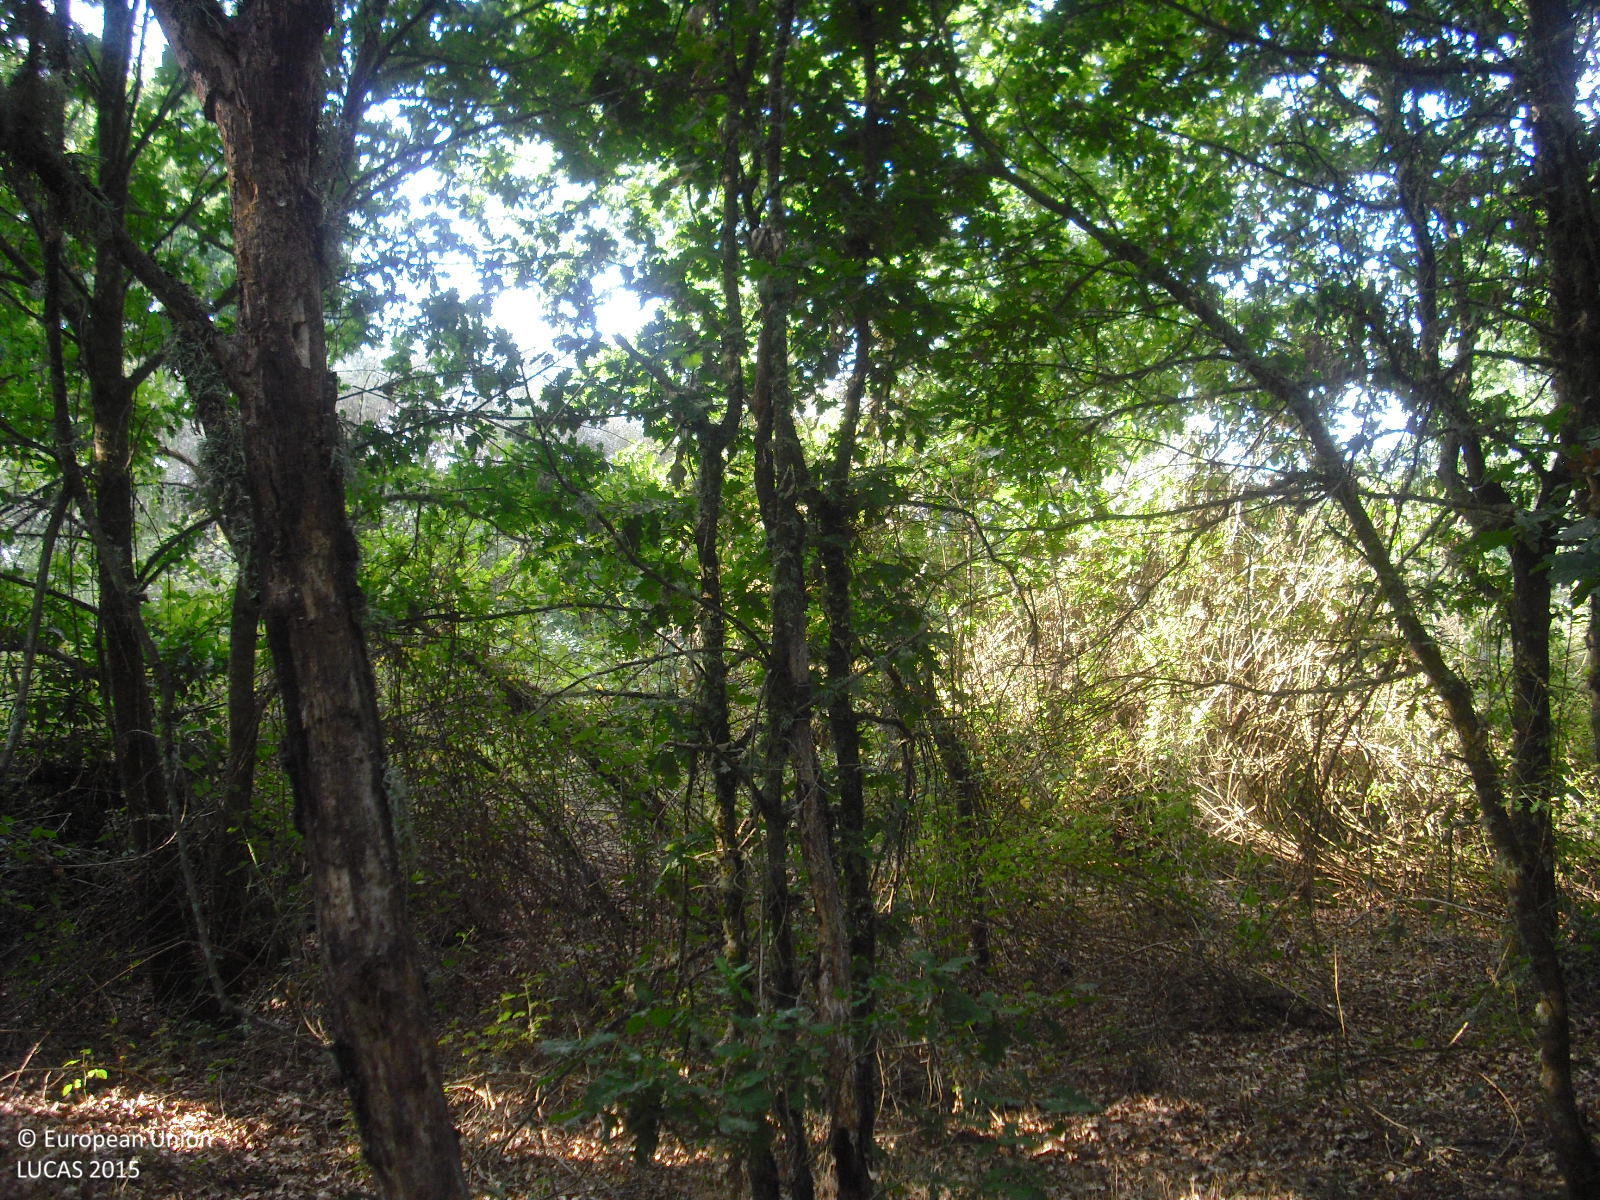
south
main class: Woodland
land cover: Broadleaved woodland
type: thermophilous deciduous forest
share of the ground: > 75 %
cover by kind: broadleaved forest trees 80 %, shrubs 20 %
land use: Semi-natural and natural areas not in use
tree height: > 5 m
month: July
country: ES
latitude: 42.5763
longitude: -7.4796
